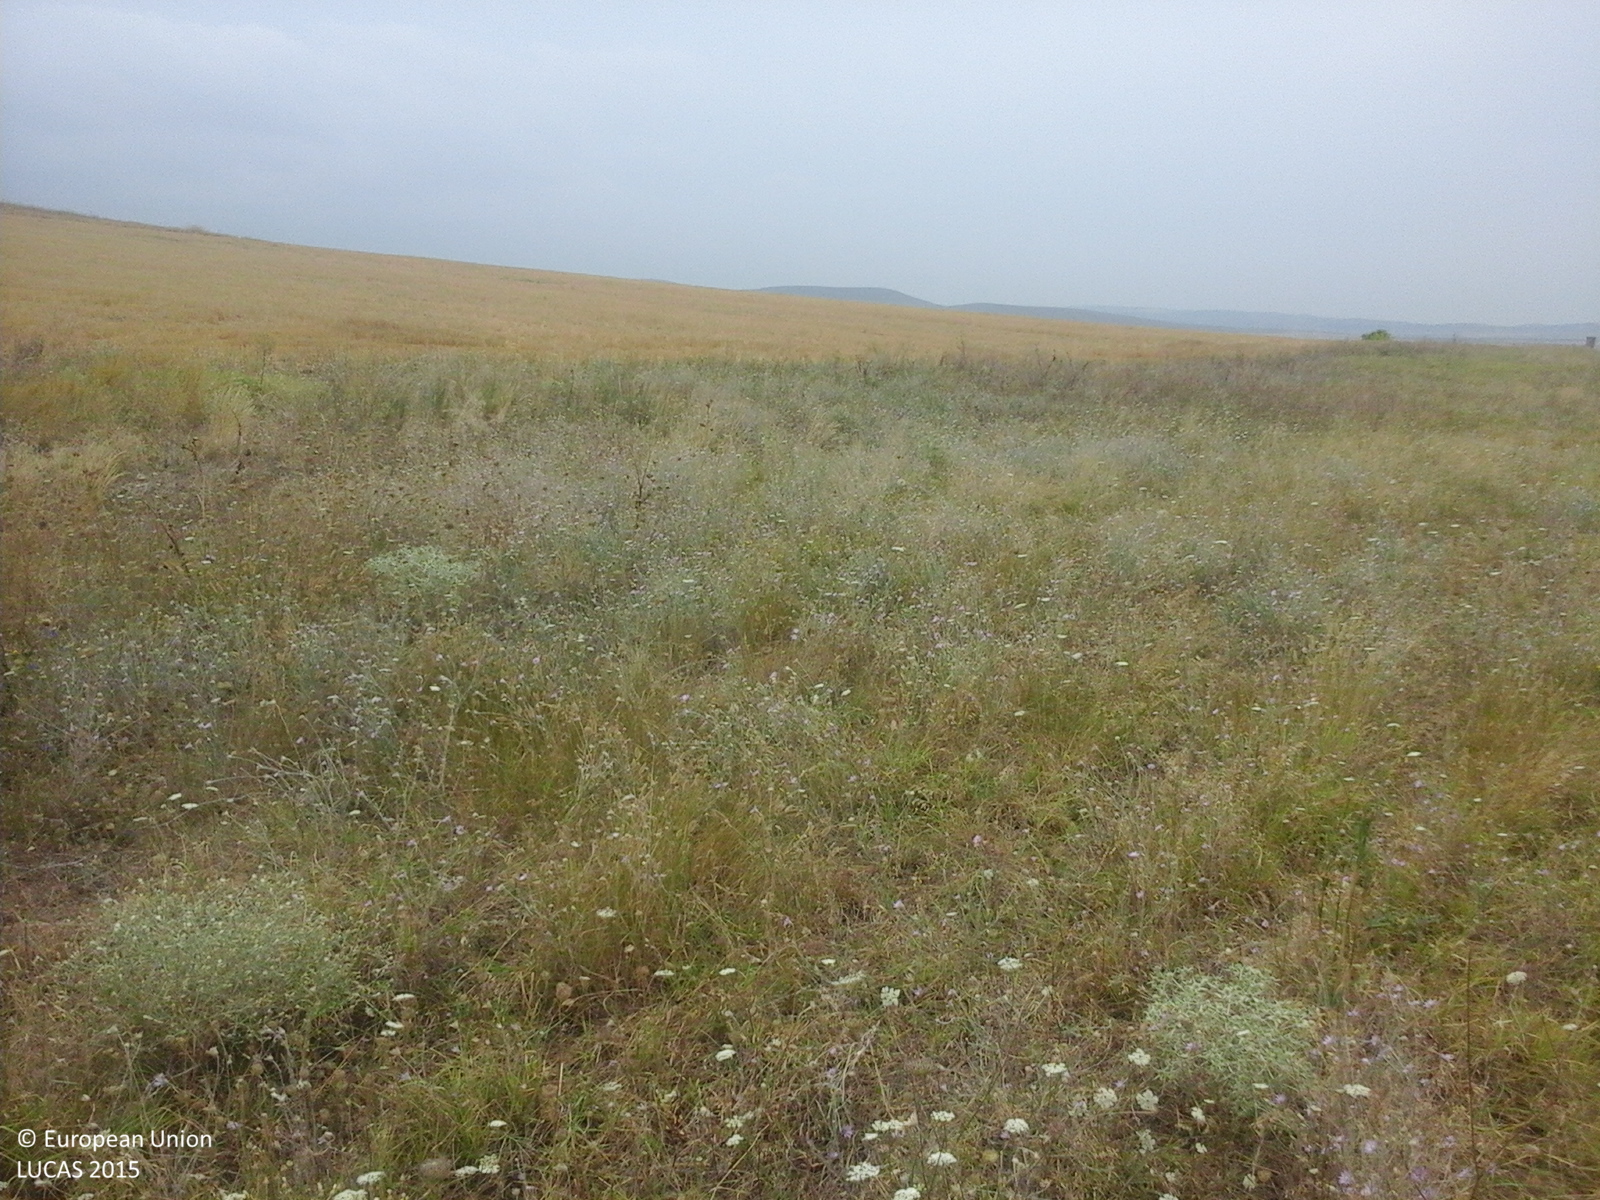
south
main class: Grassland
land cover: Grassland without tree/shrub cover
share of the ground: > 75 %
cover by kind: herbaceous plants 100 %
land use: Agriculture (excluding fallow land and kitchen gardens)
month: July
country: RO
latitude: 45.0558
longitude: 28.2676
